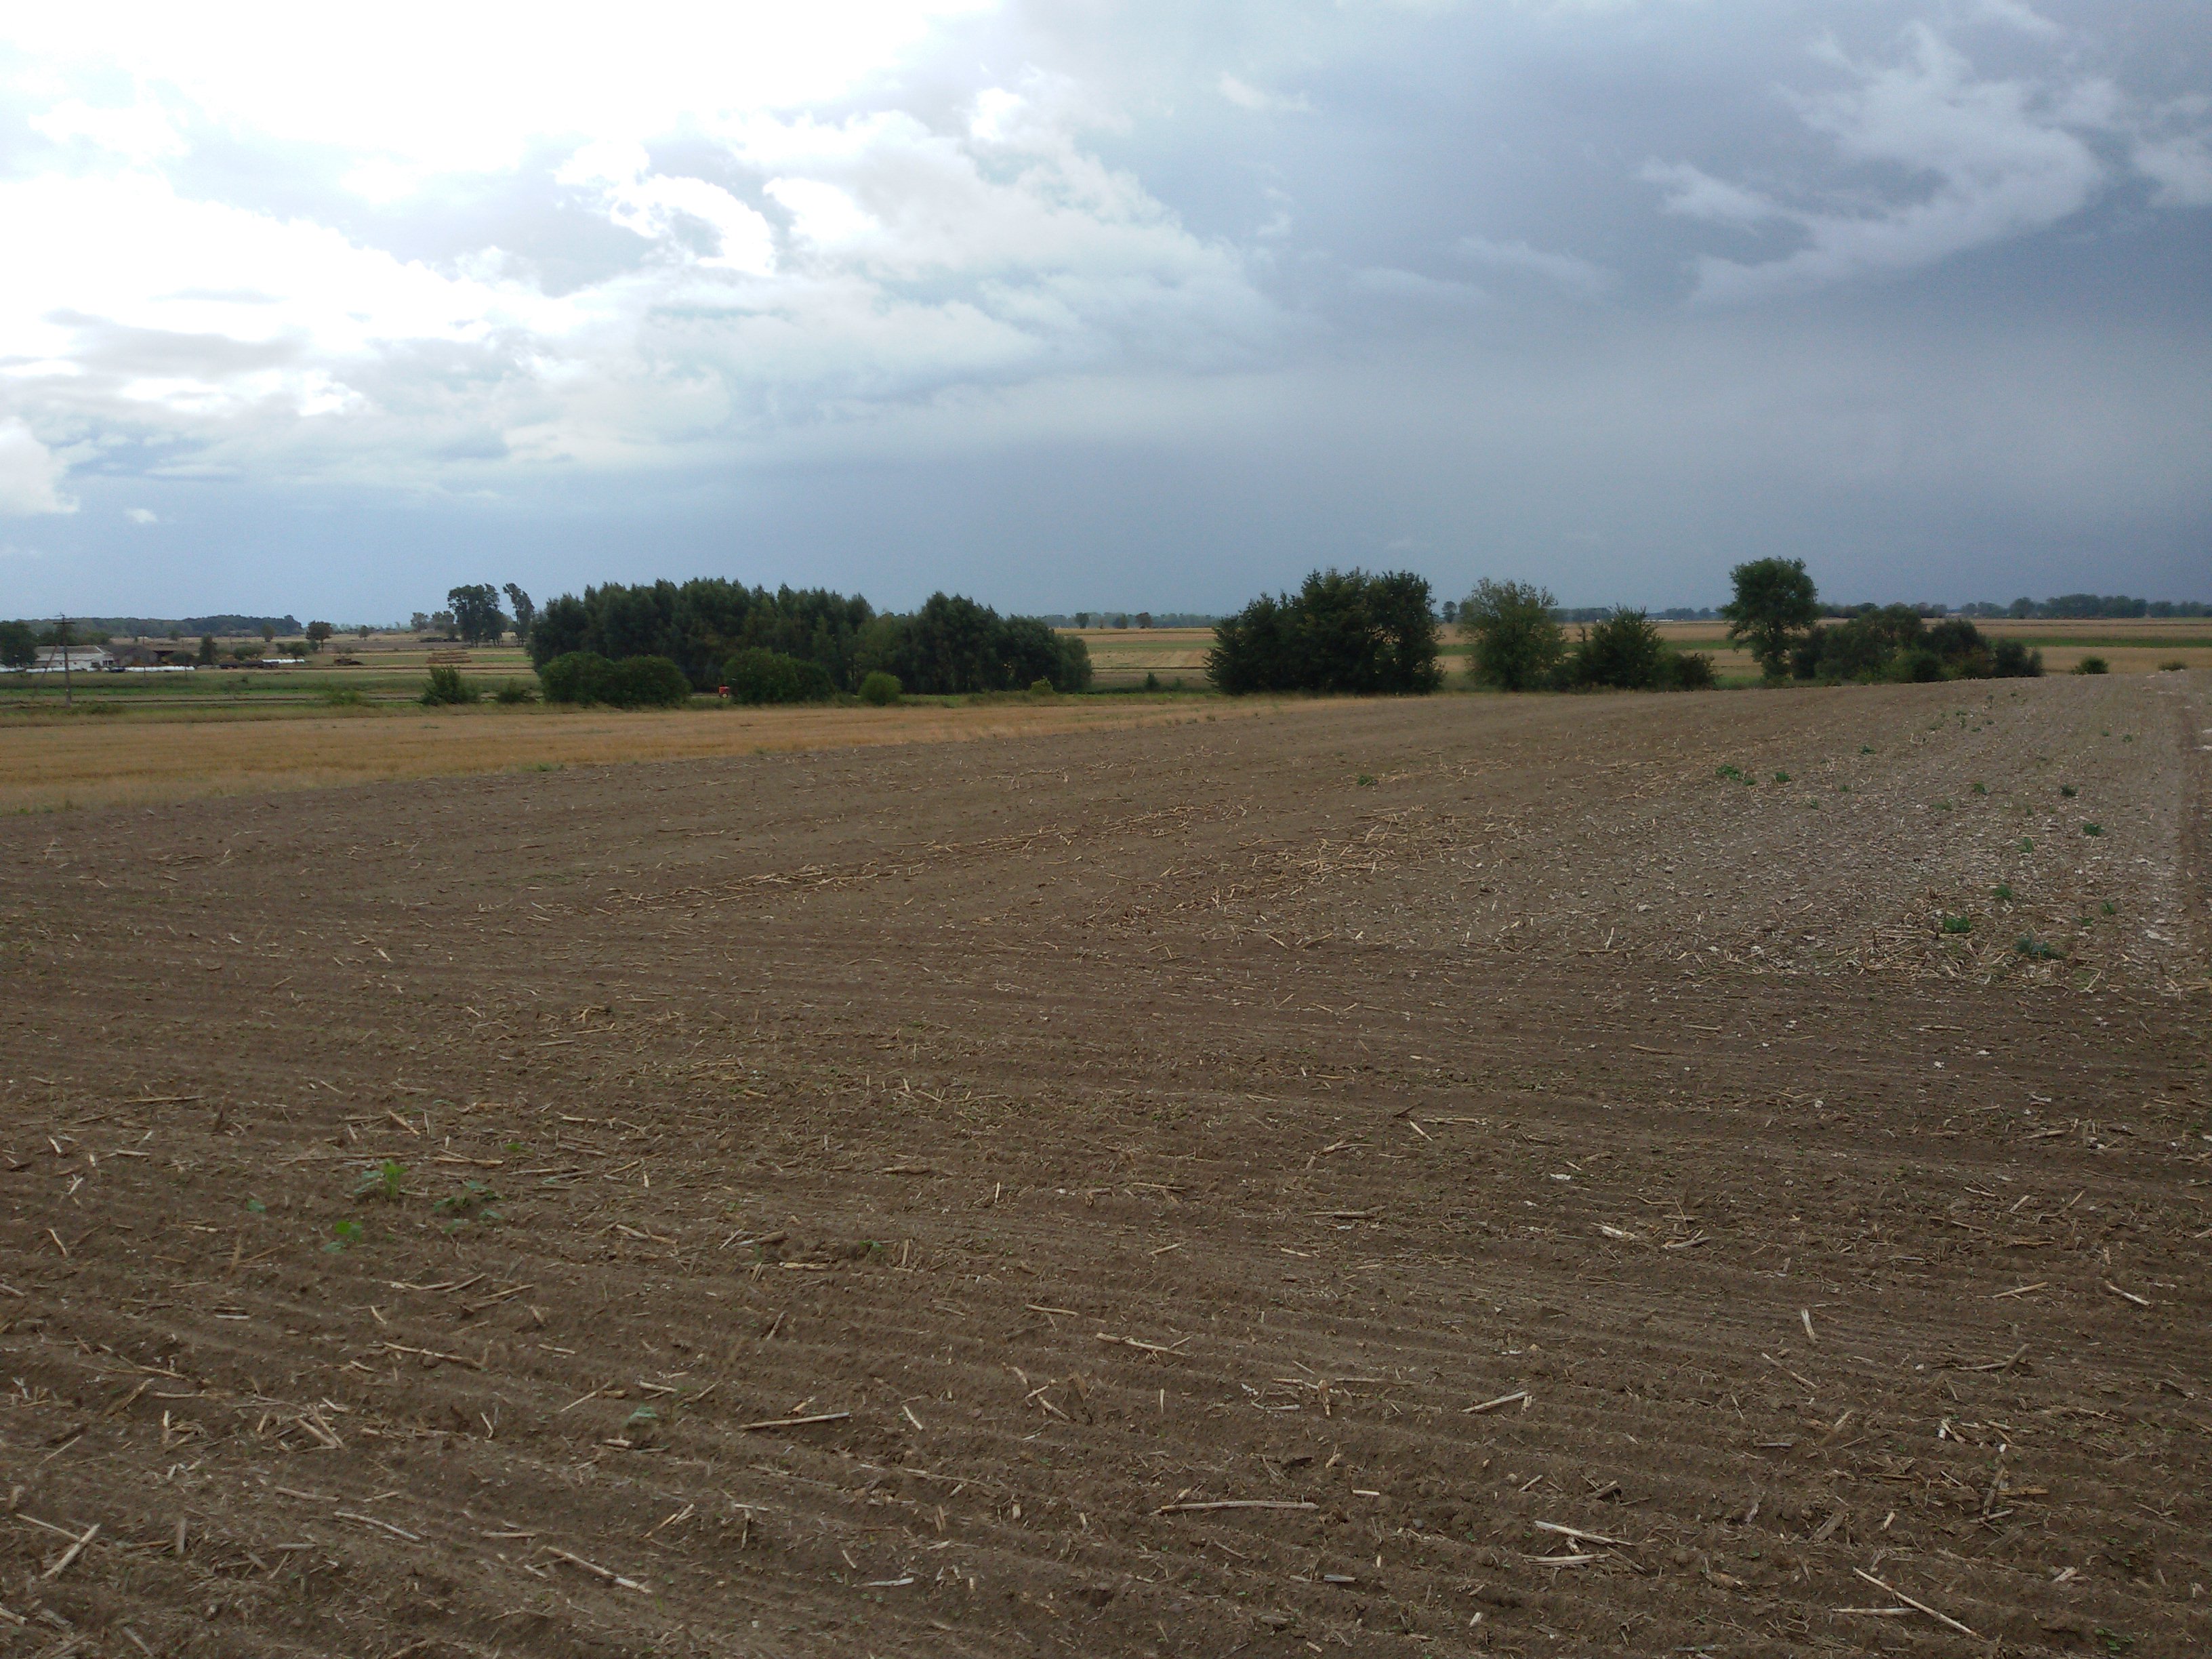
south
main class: Cropland
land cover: Rape and turnip rape
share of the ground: < 10 %
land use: Agriculture (excluding fallow land and kitchen gardens)
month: September
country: PL
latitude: 52.8220
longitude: 17.5660
